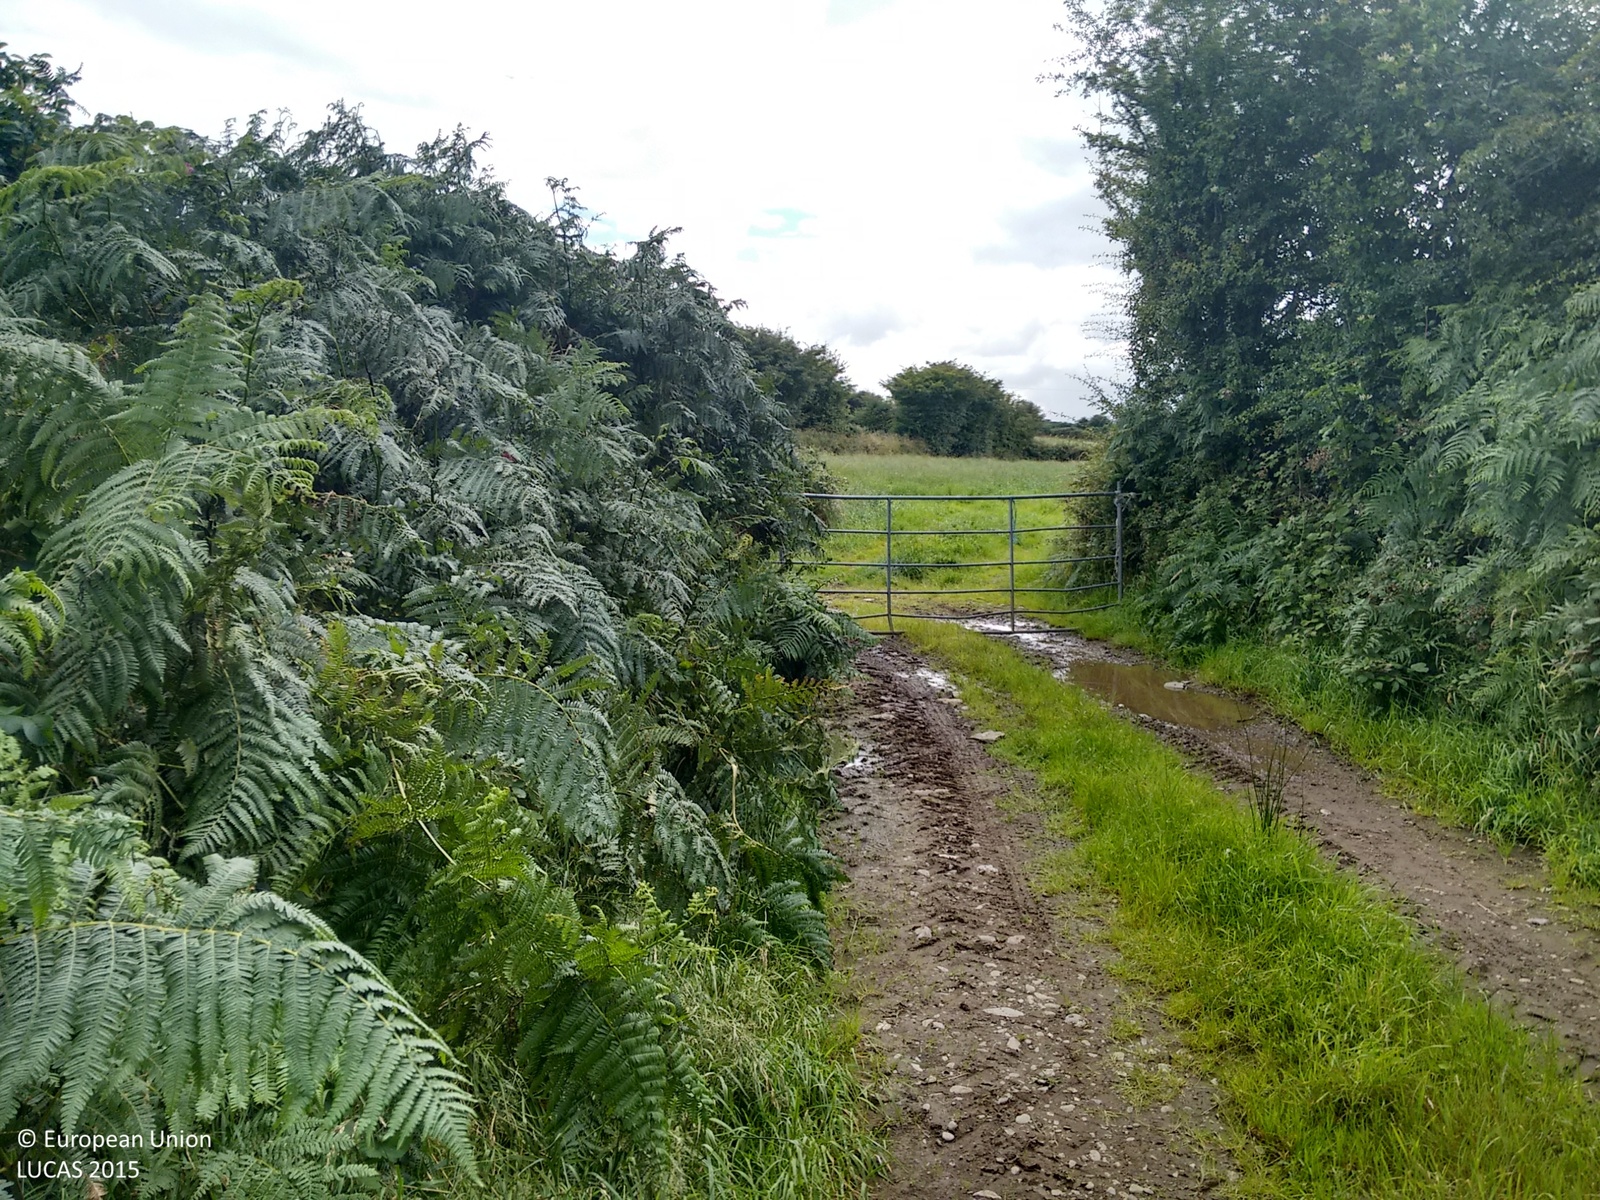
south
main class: Grassland
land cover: Grassland without tree/shrub cover
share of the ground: > 75 %
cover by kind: herbaceous plants 95 %, shrubs 5 %
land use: Agriculture (excluding fallow land and kitchen gardens)
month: August
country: IE
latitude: 52.1223
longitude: -9.7418
